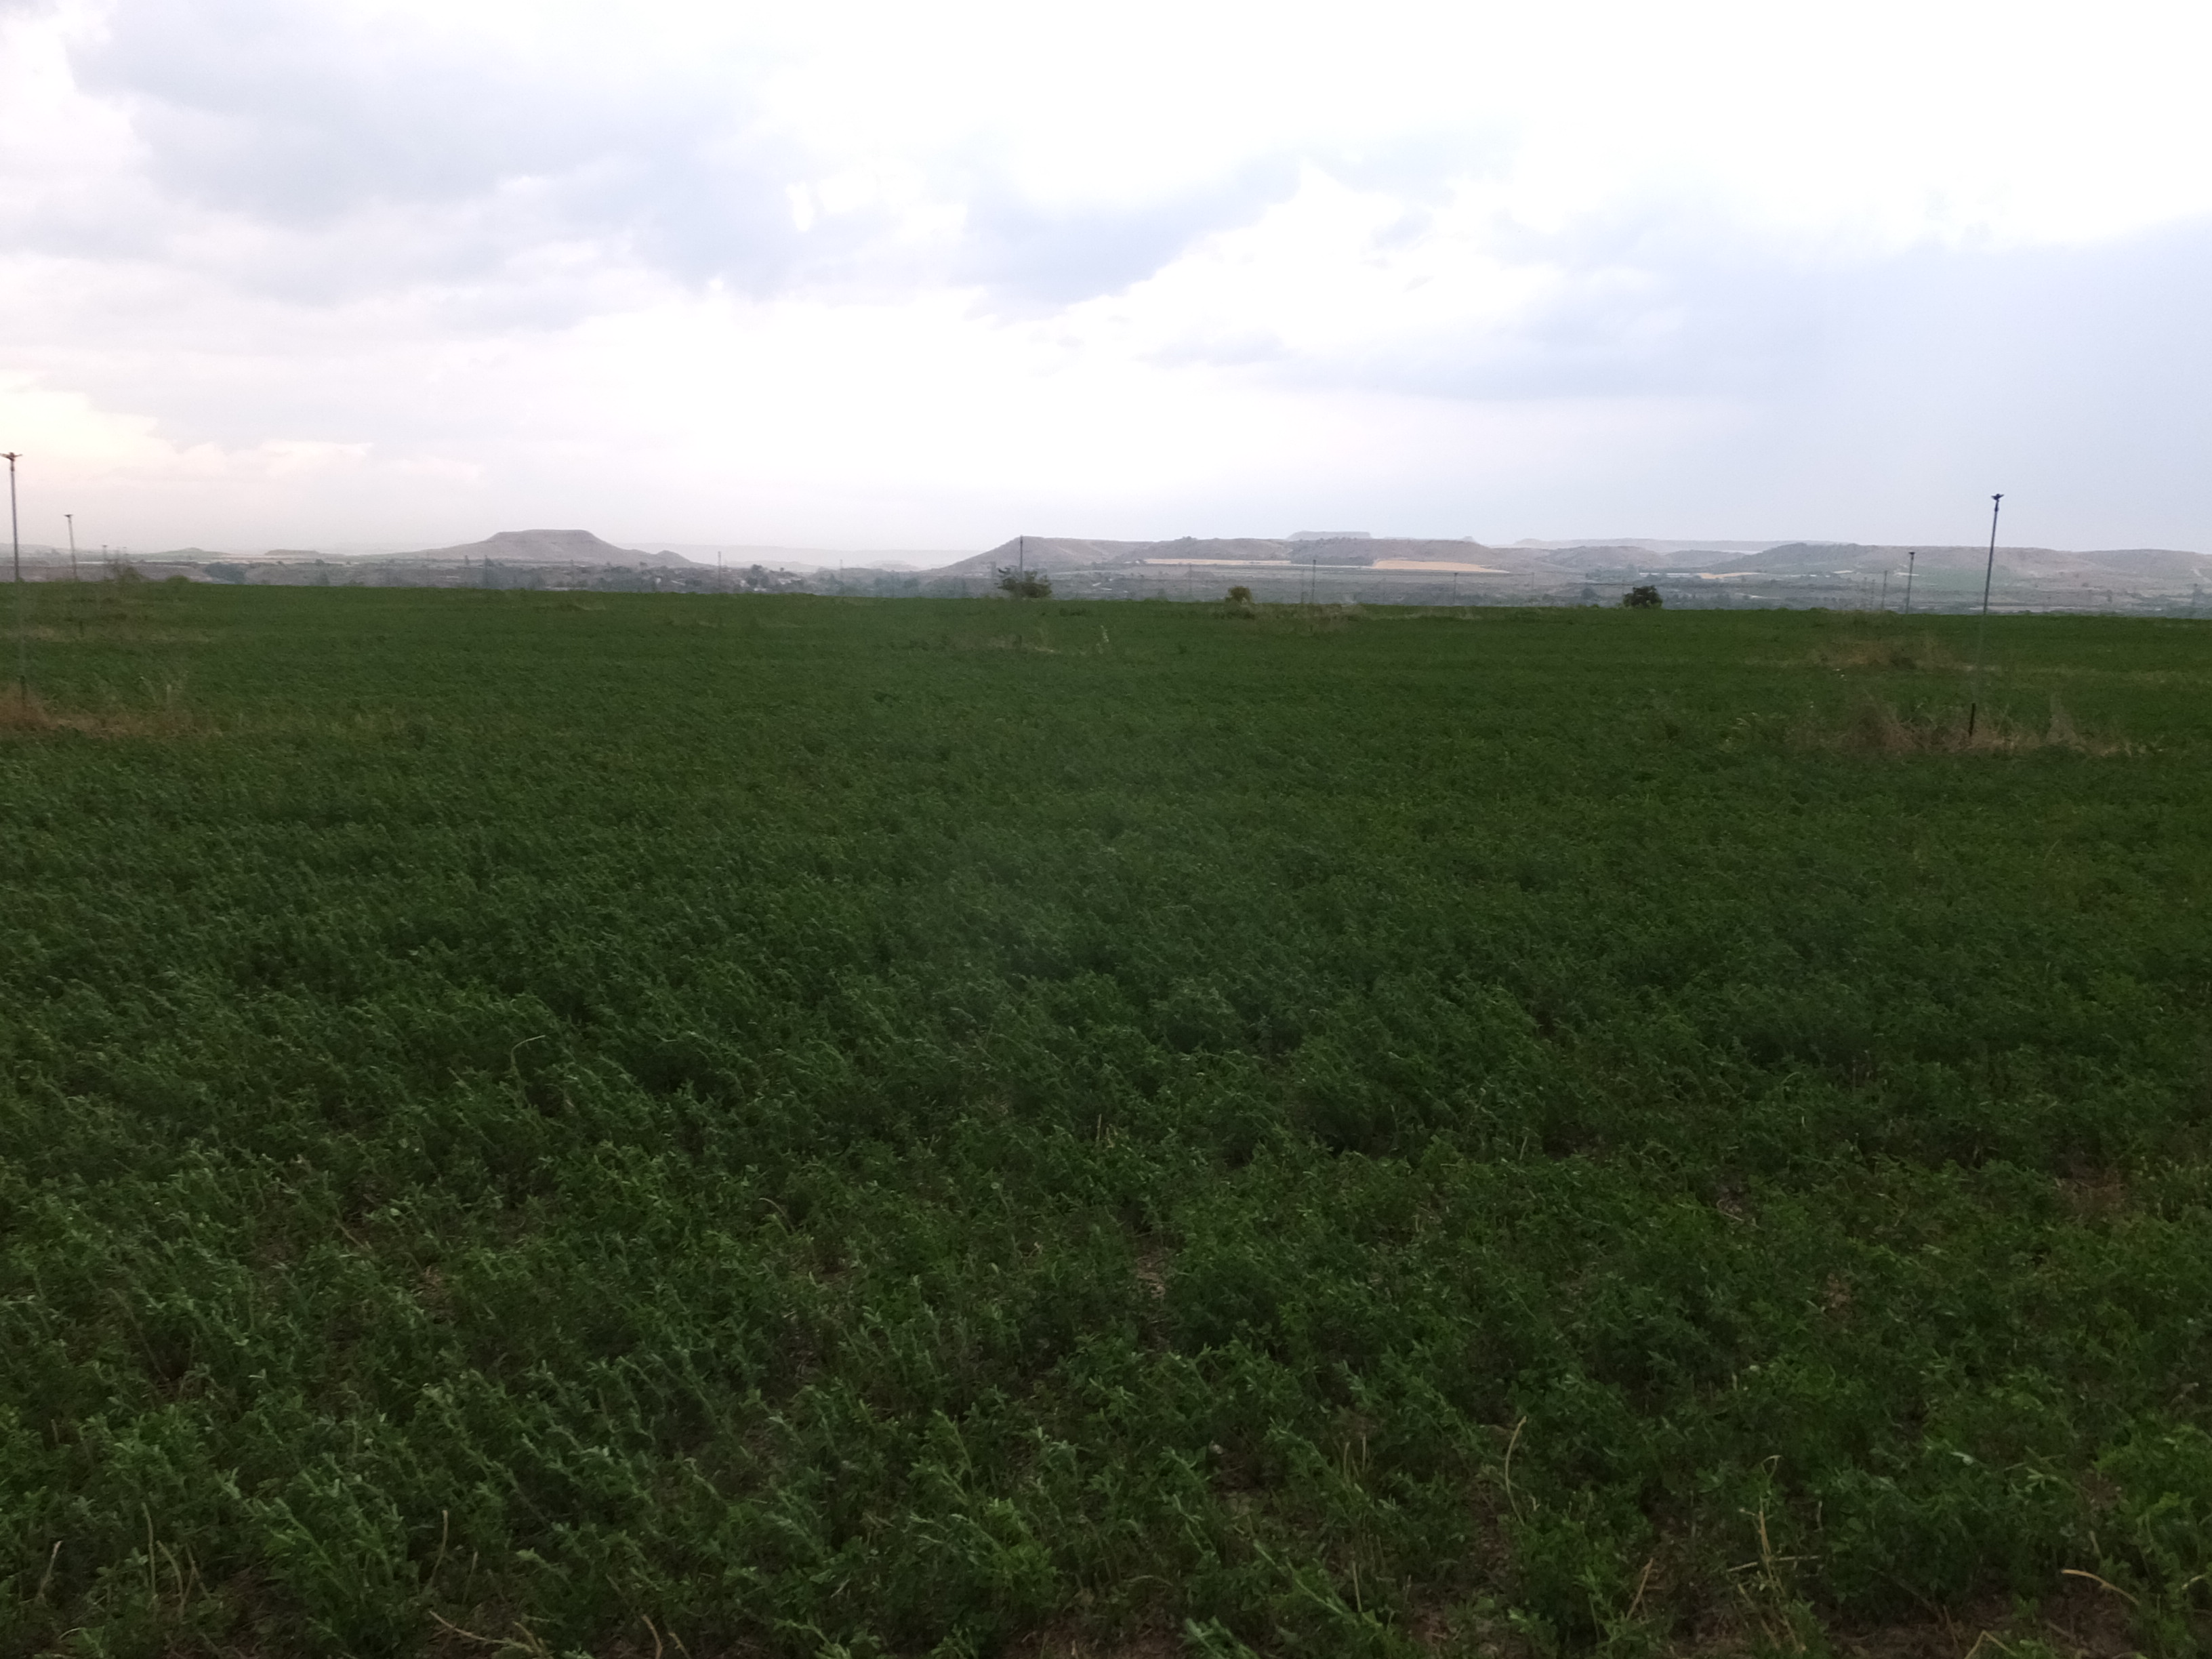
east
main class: Cropland
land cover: Lucerne
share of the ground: > 75 %
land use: Agriculture (excluding fallow land and kitchen gardens)
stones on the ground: < 10 %
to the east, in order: Lucerne; Shrubland without tree cover; Ditches and canals; Shrubland without tree cover; Rice
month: June
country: ES
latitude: 41.8246
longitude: 0.1228
